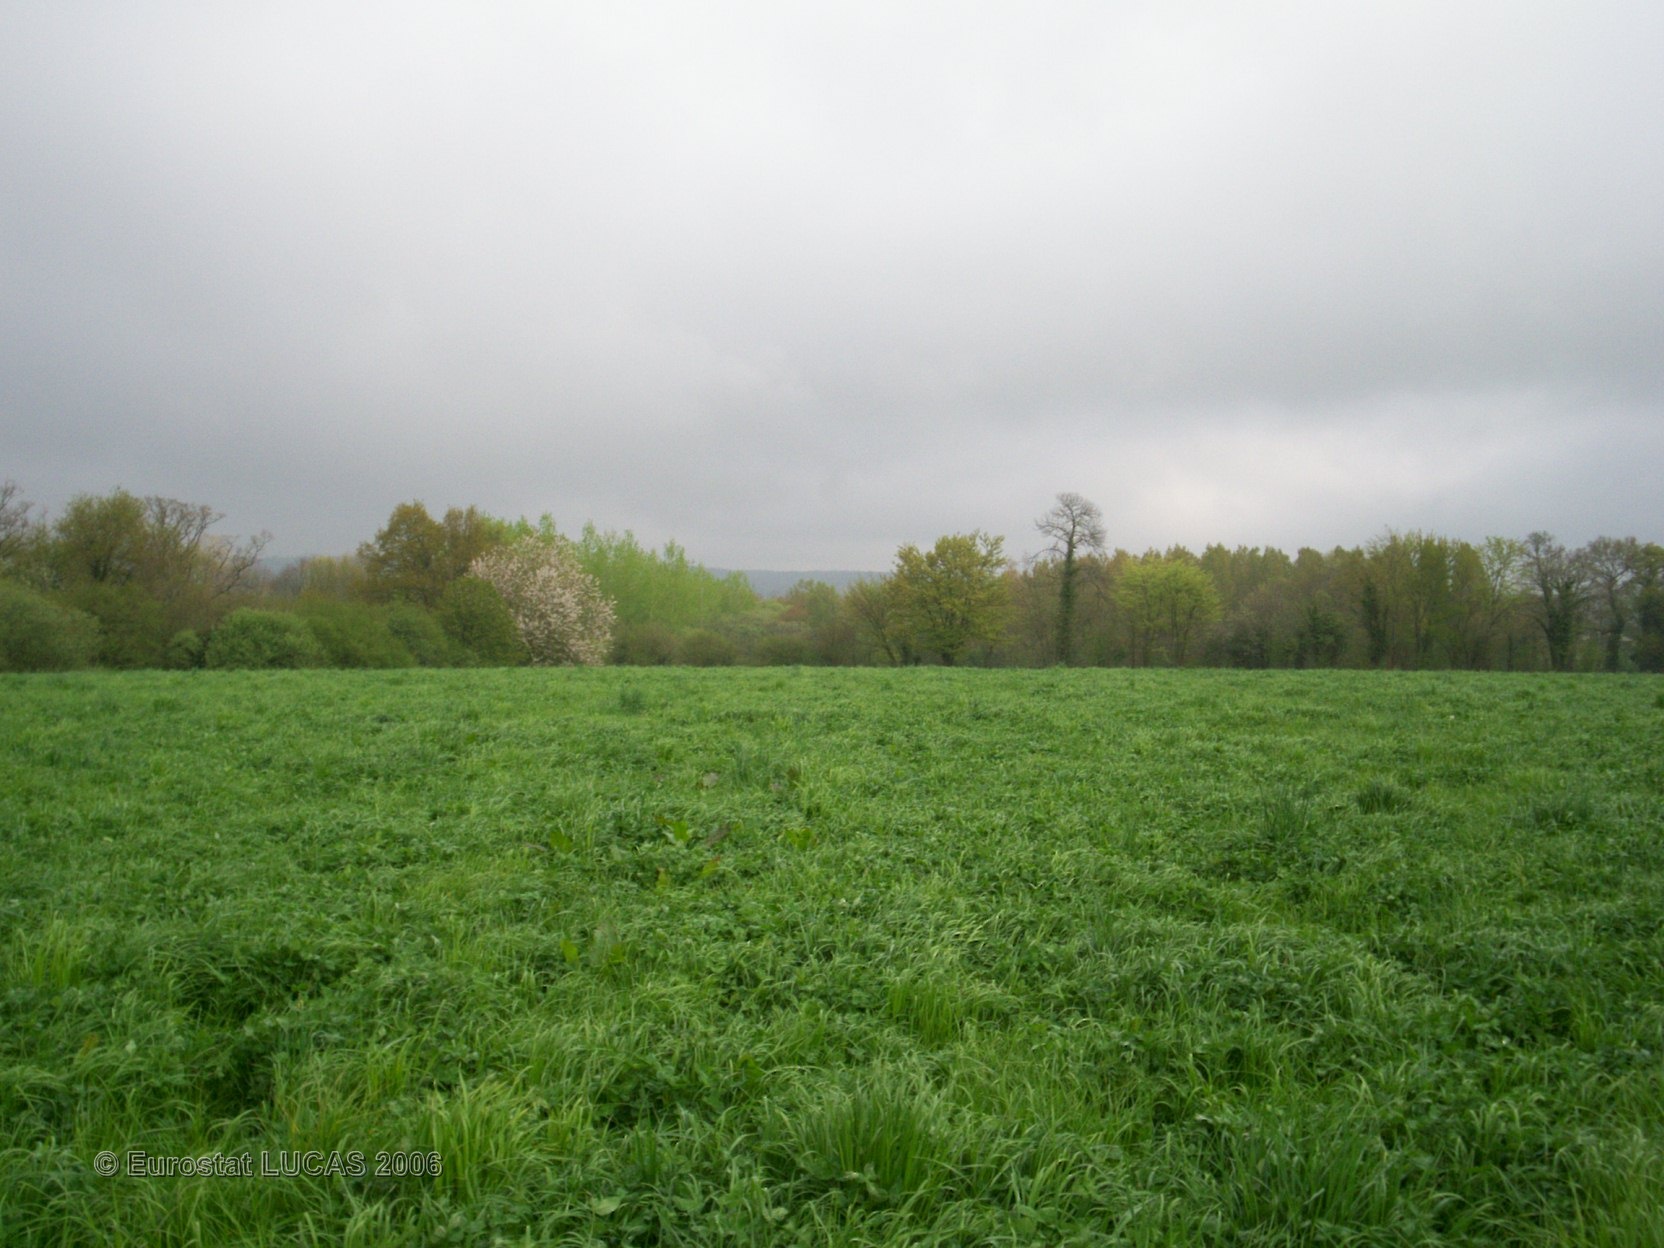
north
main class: Grassland
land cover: Grassland without tree/shrub cover
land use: Agriculture (excluding fallow land and kitchen gardens)
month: May
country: FR
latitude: 47.7646
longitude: -2.8050
